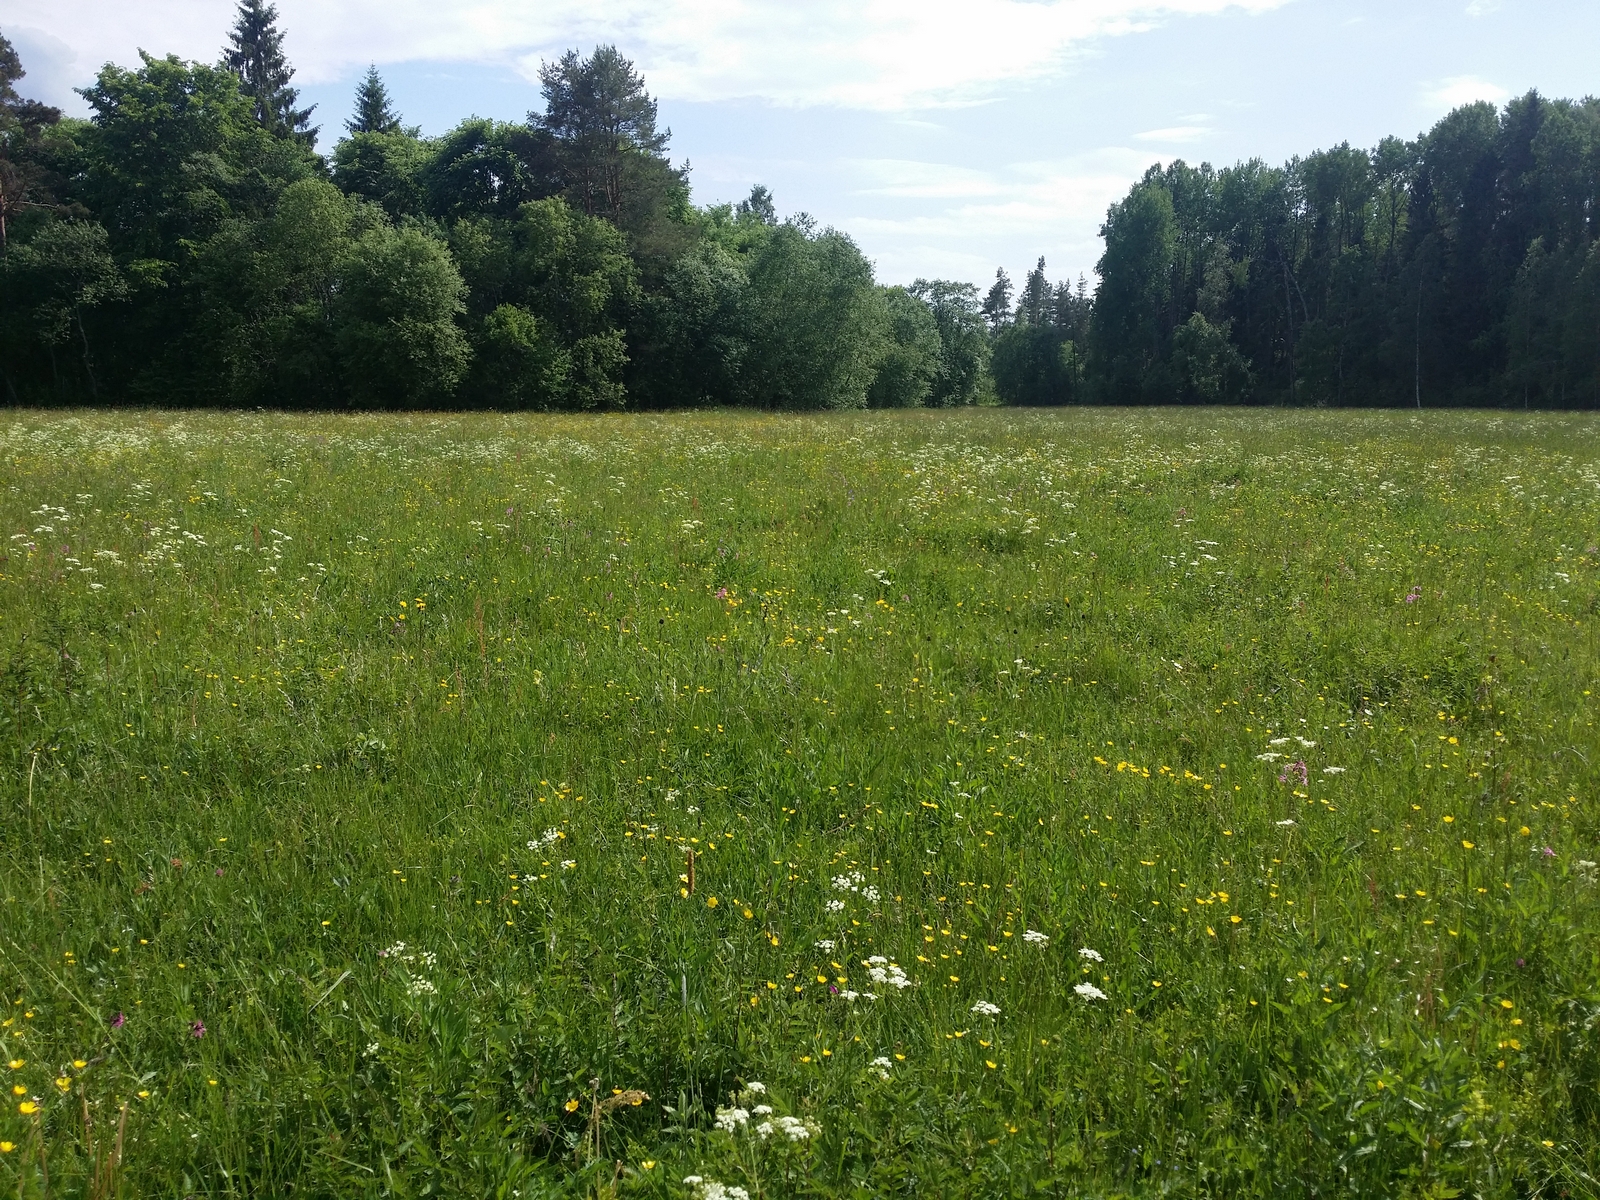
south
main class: Grassland
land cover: Spontaneously vegetated surfaces
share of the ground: > 75 %
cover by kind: herbaceous plants 100 %
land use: Fallow land
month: June
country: LV
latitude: 57.3740
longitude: 26.4902
